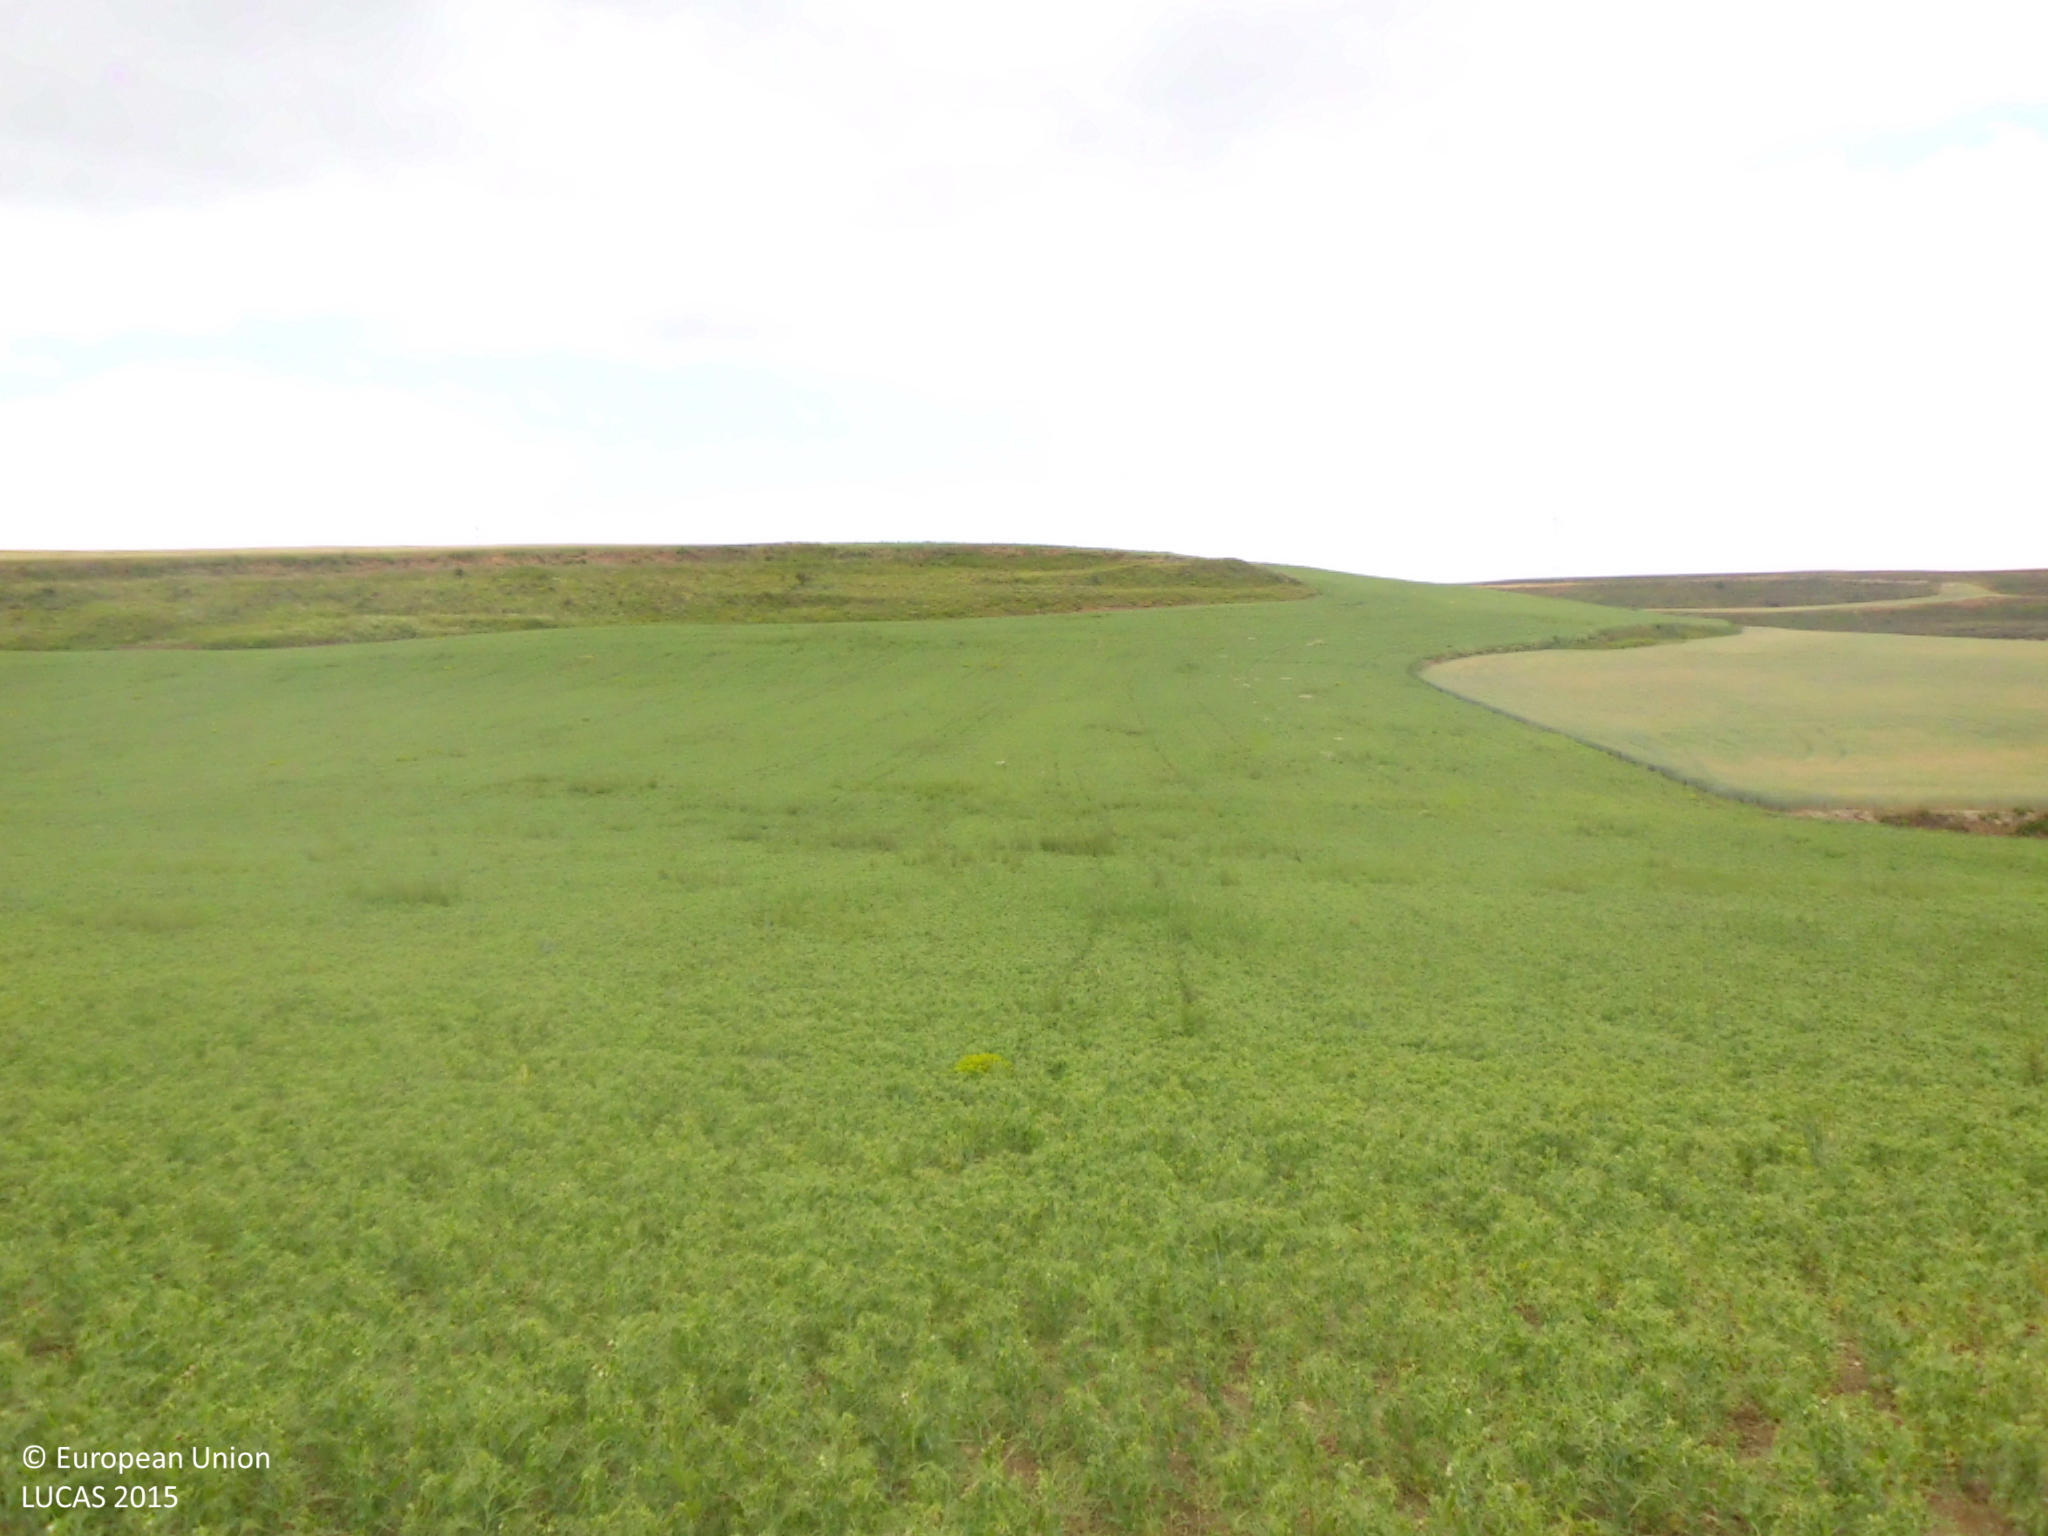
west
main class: Cropland
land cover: Dry pulses
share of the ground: > 75 %
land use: Agriculture (excluding fallow land and kitchen gardens)
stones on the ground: < 10 %
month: June
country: ES
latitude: 42.4993
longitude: -3.3325
